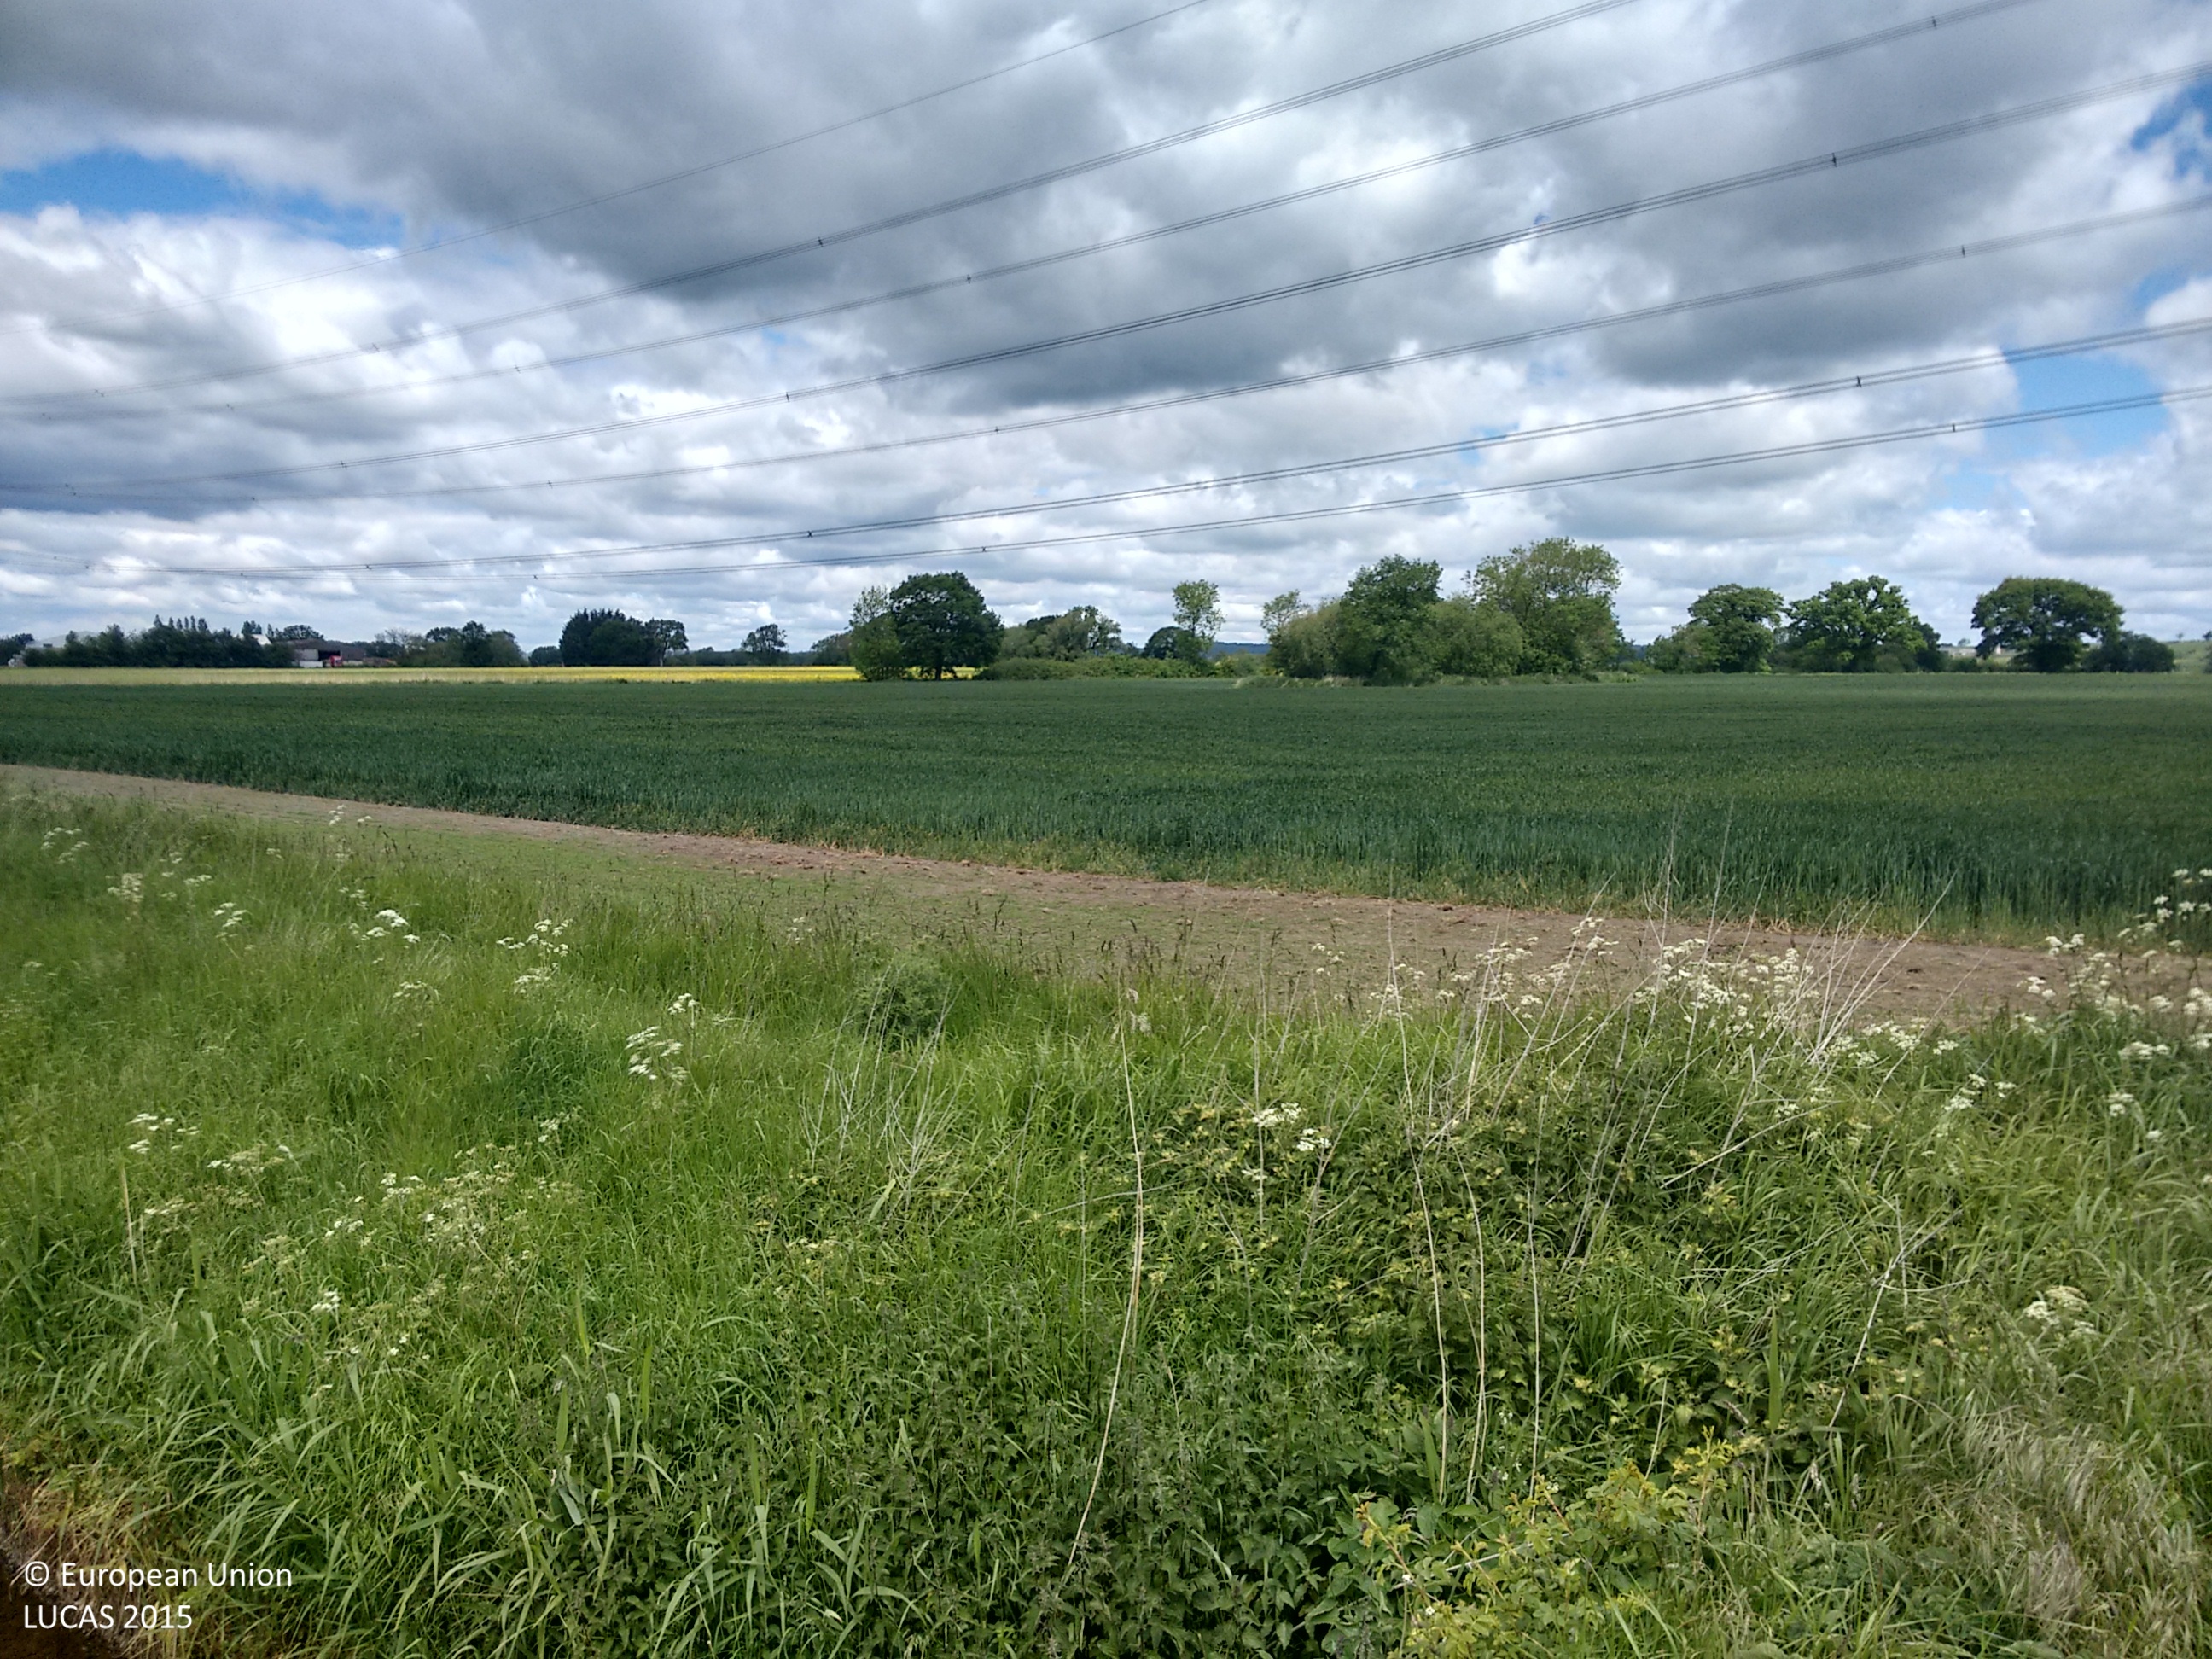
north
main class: Cropland
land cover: Potatoes
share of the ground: > 75 %
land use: Agriculture (excluding fallow land and kitchen gardens)
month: June
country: GB
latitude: 54.0735
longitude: -1.0621
